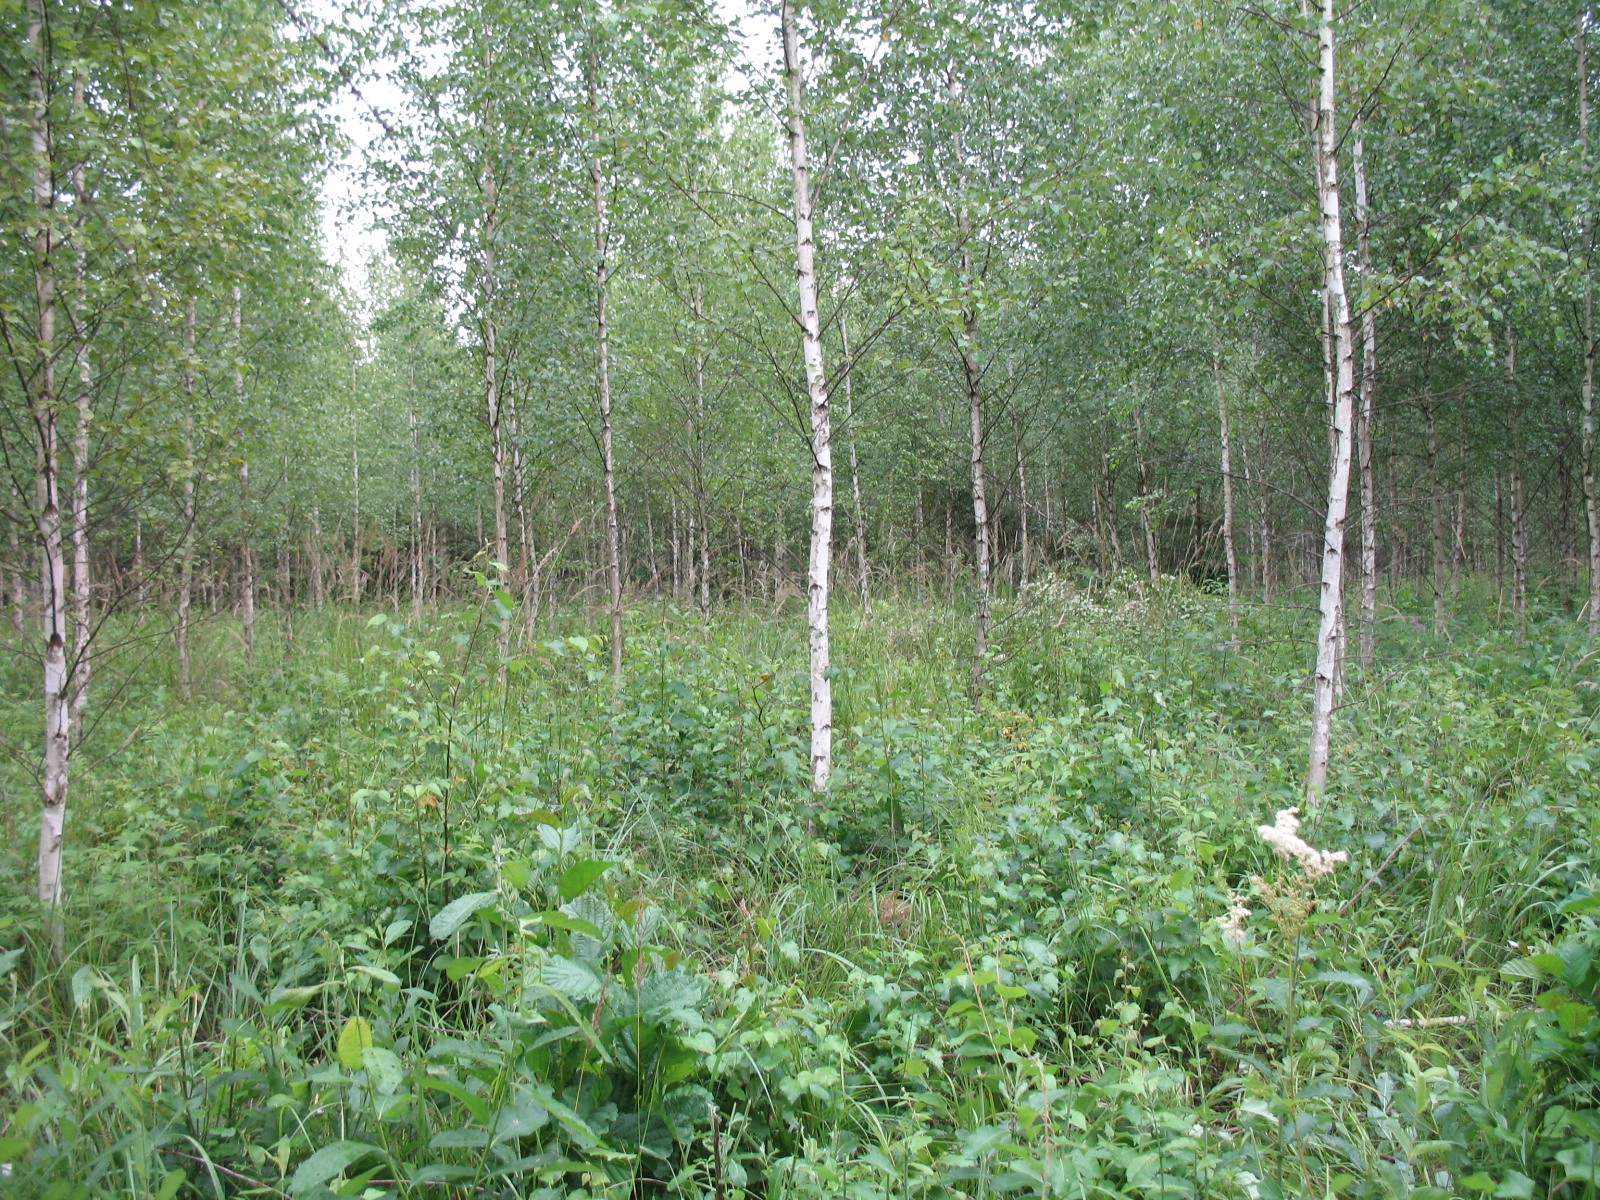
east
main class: Woodland
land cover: Broadleaved woodland
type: non-riverine alder, birch or aspen forest
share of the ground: 50 - 75 %
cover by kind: broadleaved forest trees 60 %, herbaceous plants 40 %
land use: Forestry
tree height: > 5 m
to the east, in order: Broadleaved woodland; Spruce dominated mixed woodland; Broadleaved woodland; Spruce dominated mixed woodland; Broadleaved woodland
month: July
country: LV
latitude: 56.3387
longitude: 25.0404
